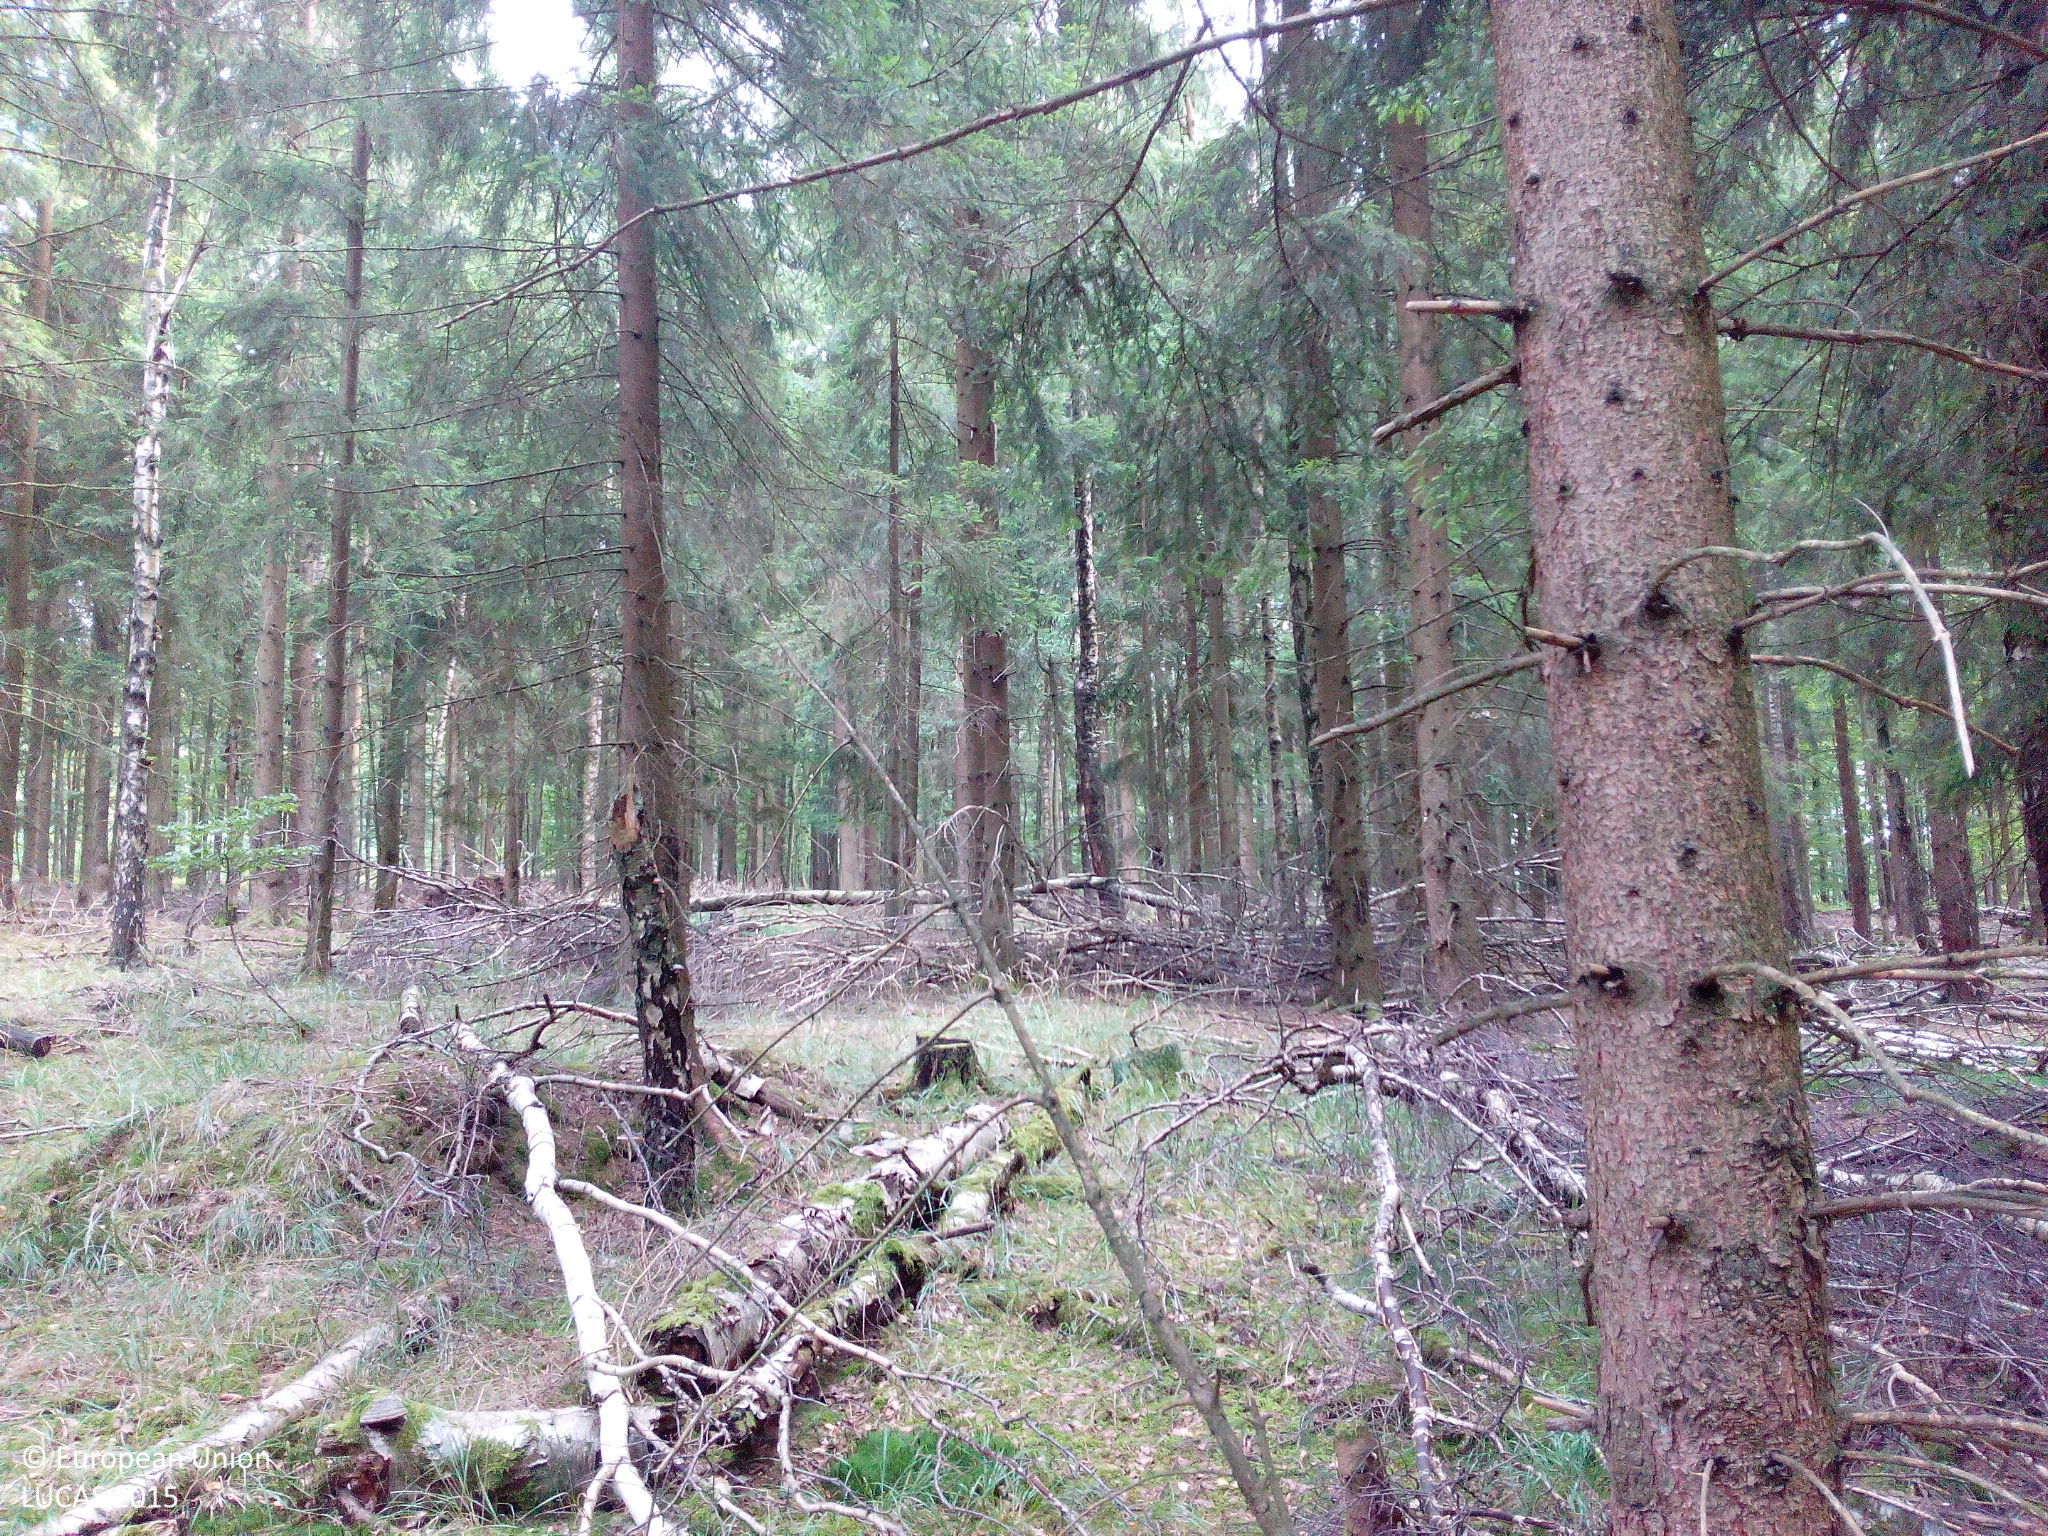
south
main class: Woodland
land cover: Spruce dominated coniferous woodland
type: hemiboreal forest and nemoral coniferous forest and mixed broadleaved-coniferous forest
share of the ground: > 75 %
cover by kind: coniferous forest trees 90 %, broadleaved forest trees 10 %
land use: Forestry
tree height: > 5 m
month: September
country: DE
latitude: 51.5821
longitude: 11.0243
